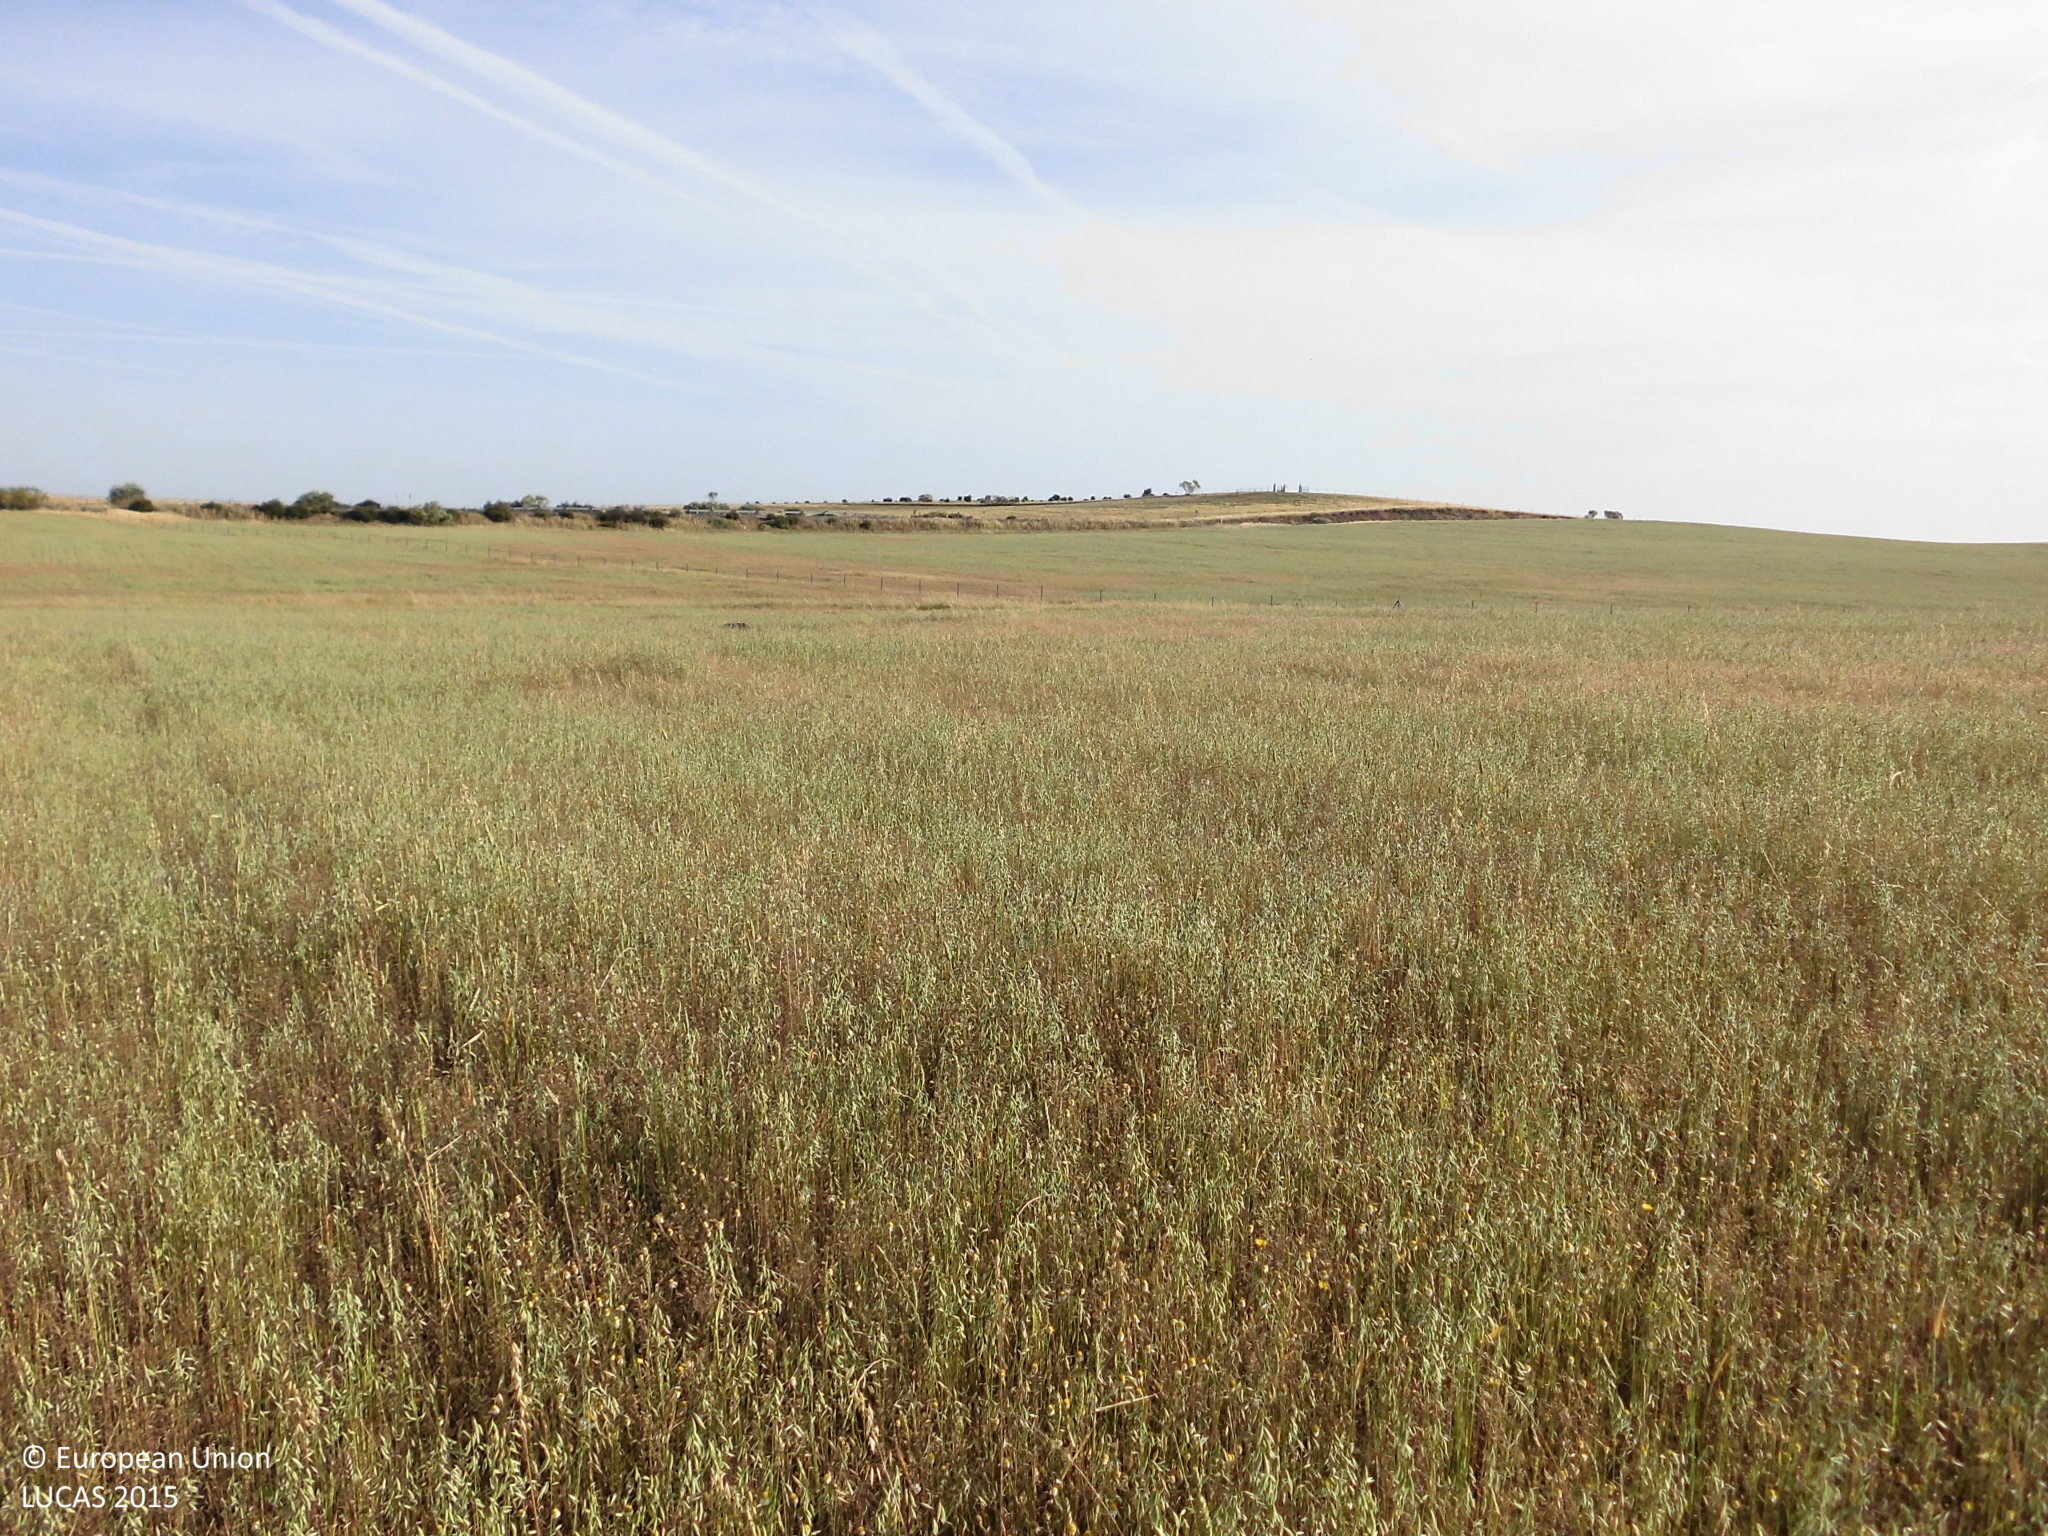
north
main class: Cropland
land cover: Oats
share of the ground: > 75 %
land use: Agriculture (excluding fallow land and kitchen gardens)
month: May
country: ES
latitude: 39.6084
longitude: -6.9593
